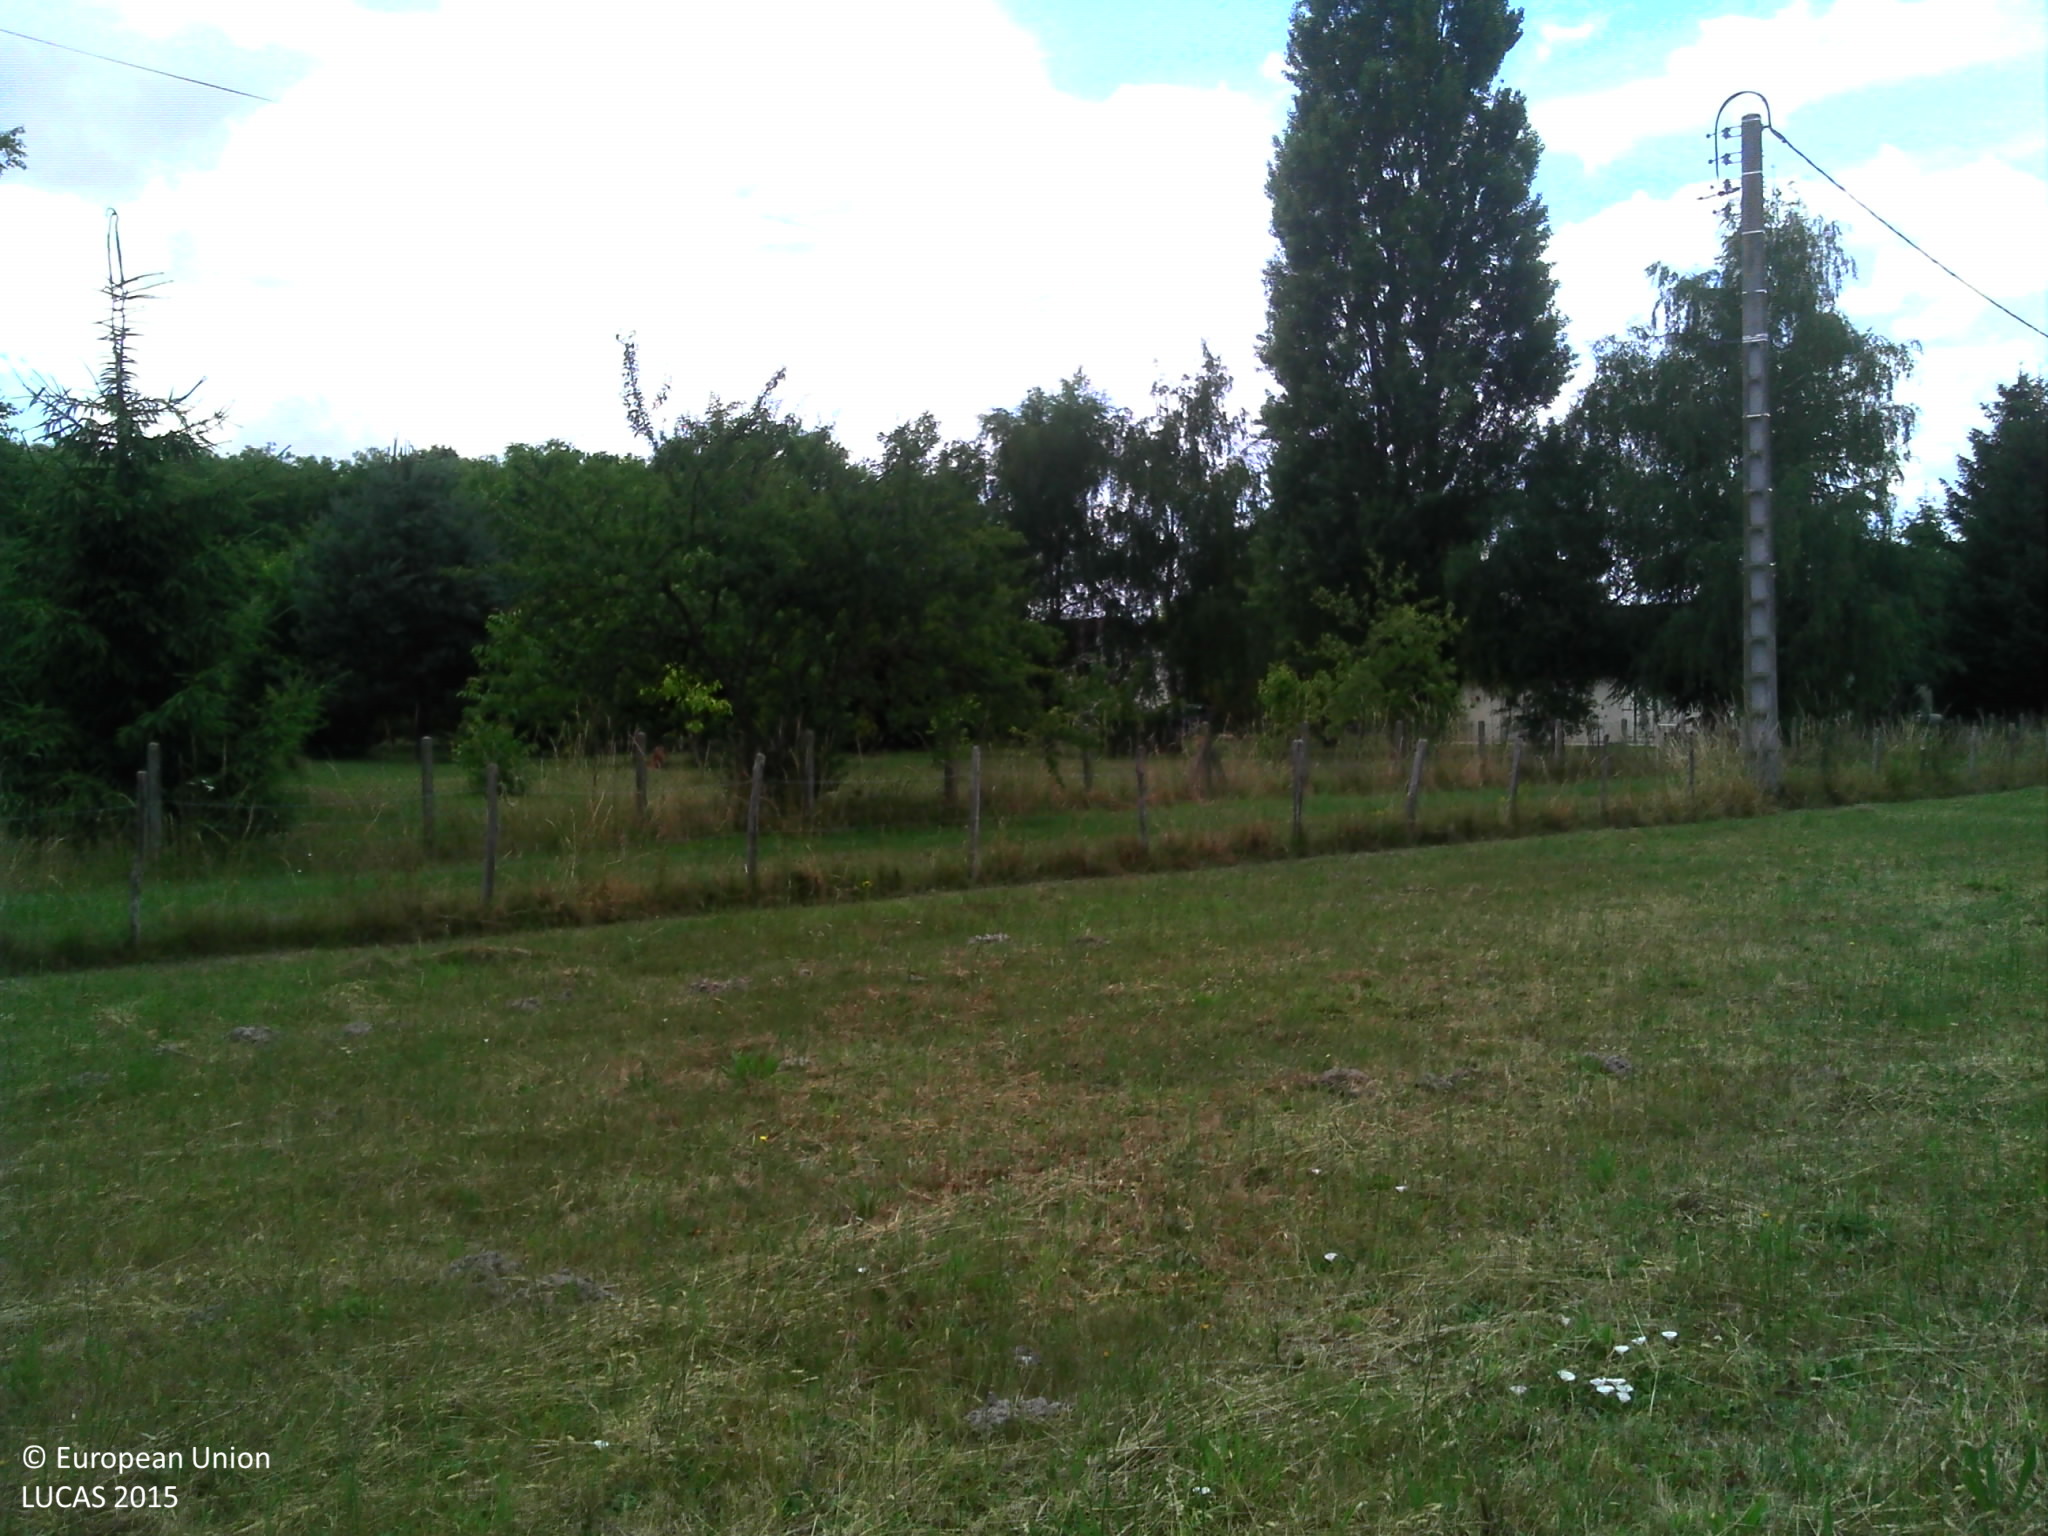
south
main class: Grassland
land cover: Grassland without tree/shrub cover
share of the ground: > 75 %
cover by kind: herbaceous plants 100 %
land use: Agriculture (excluding fallow land and kitchen gardens)
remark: Harvested field
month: June
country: FR
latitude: 47.4226
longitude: 0.3940
